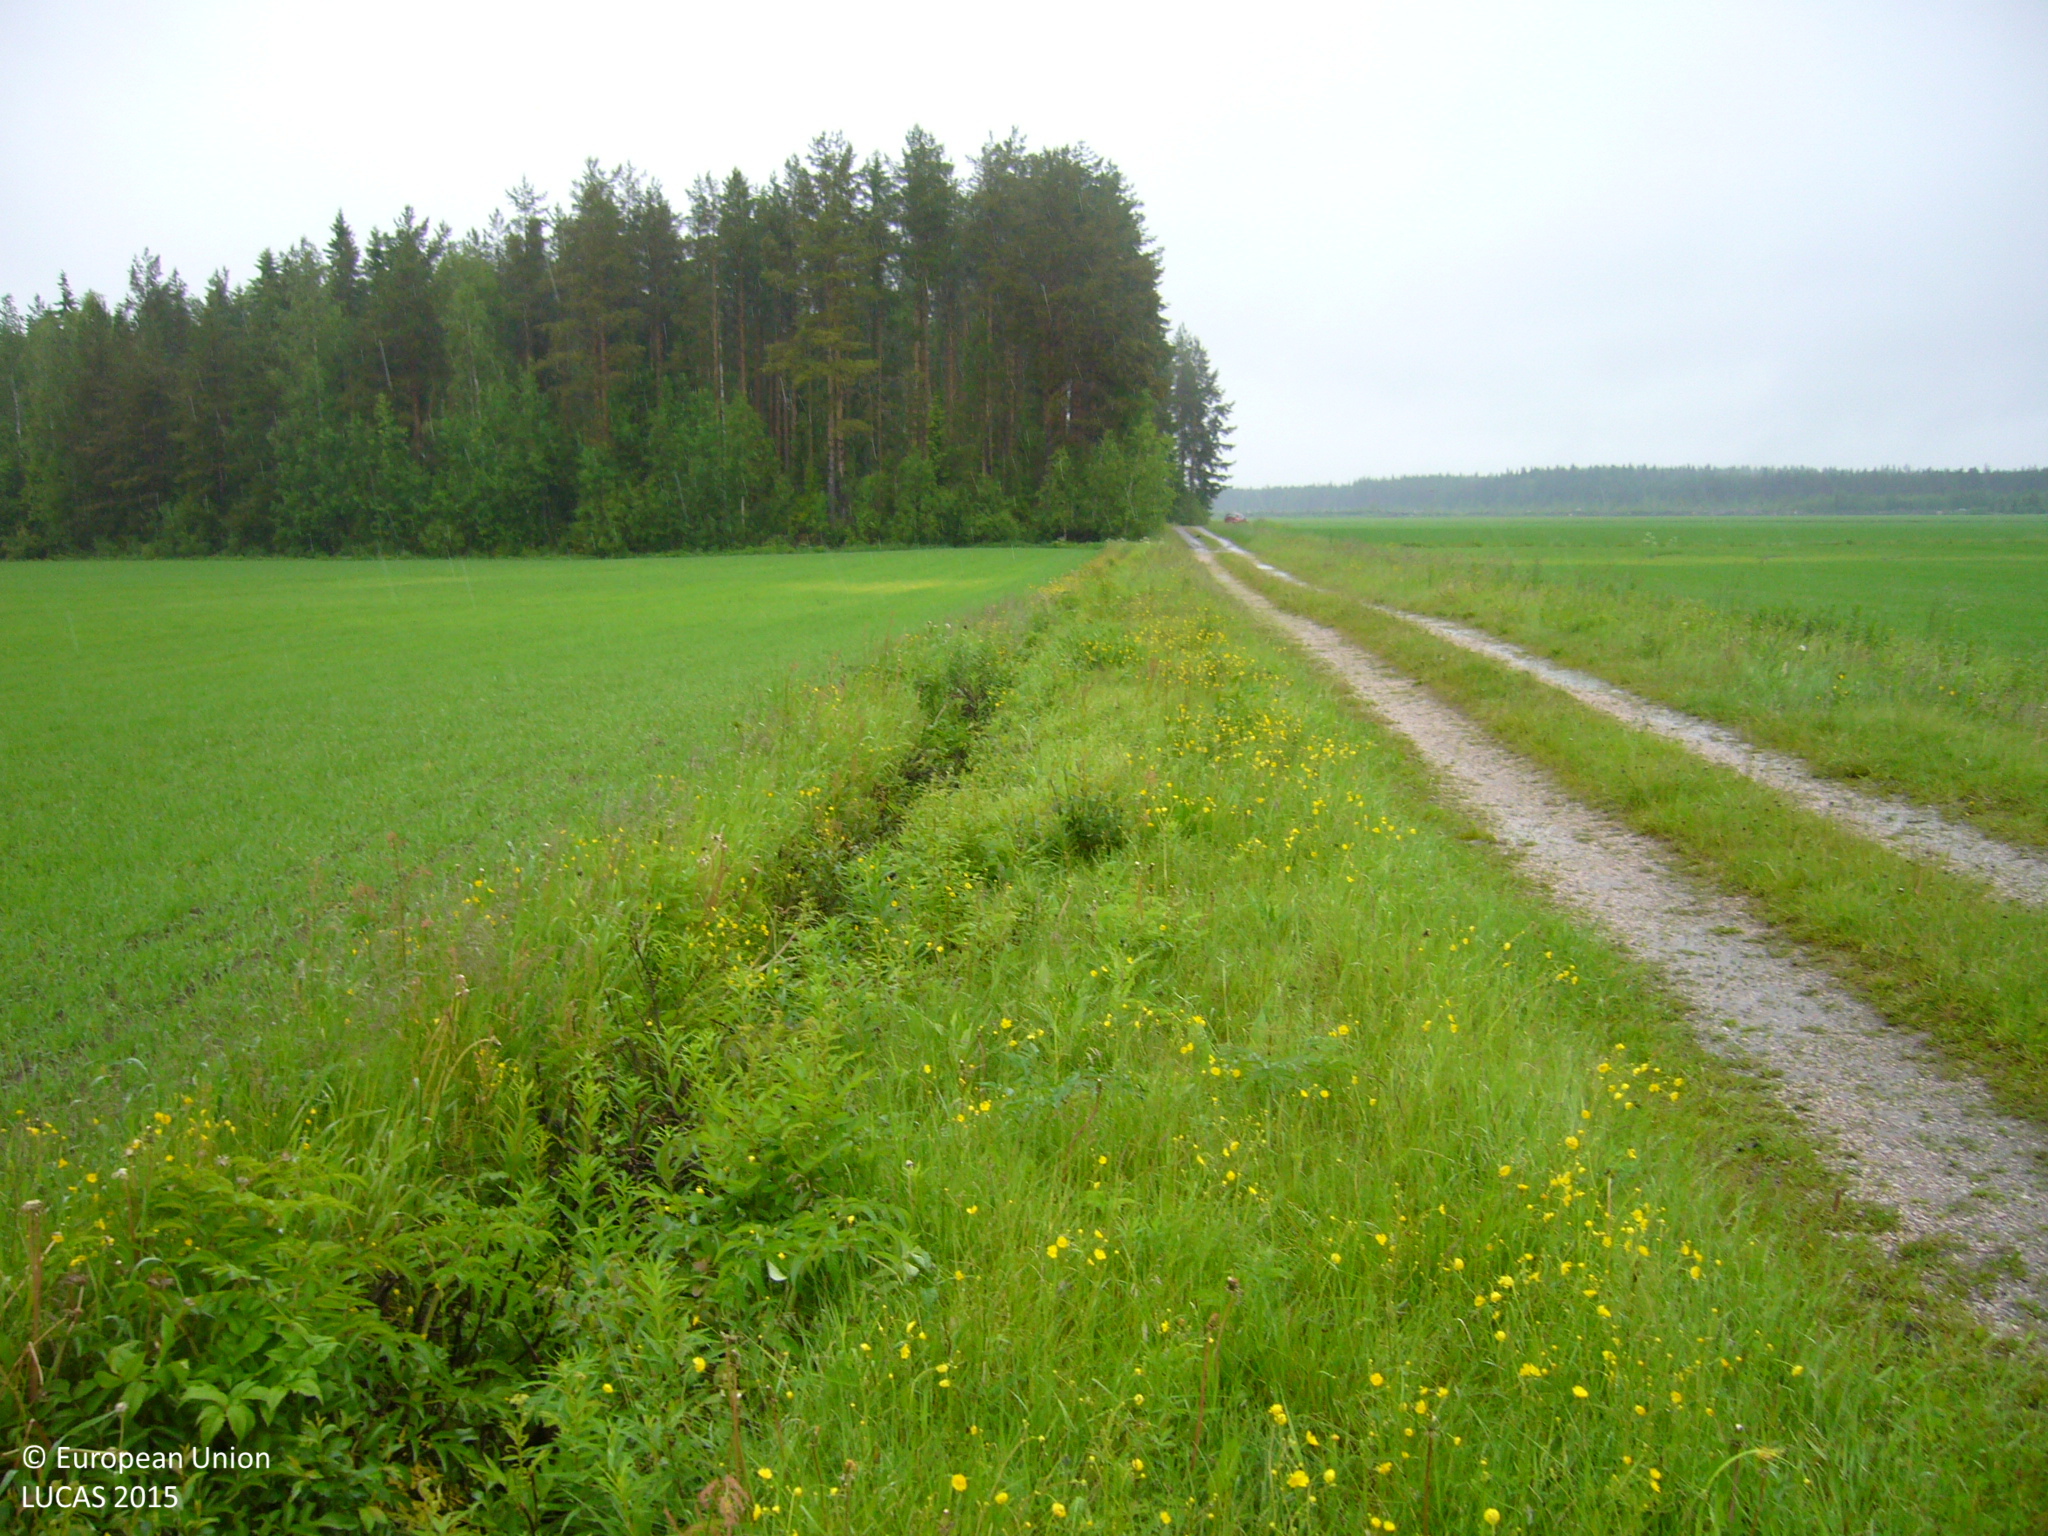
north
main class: Cropland
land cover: Barley
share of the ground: 50 - 75 %
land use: Agriculture (excluding fallow land and kitchen gardens)
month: June
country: FI
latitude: 63.7958
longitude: 25.1306
